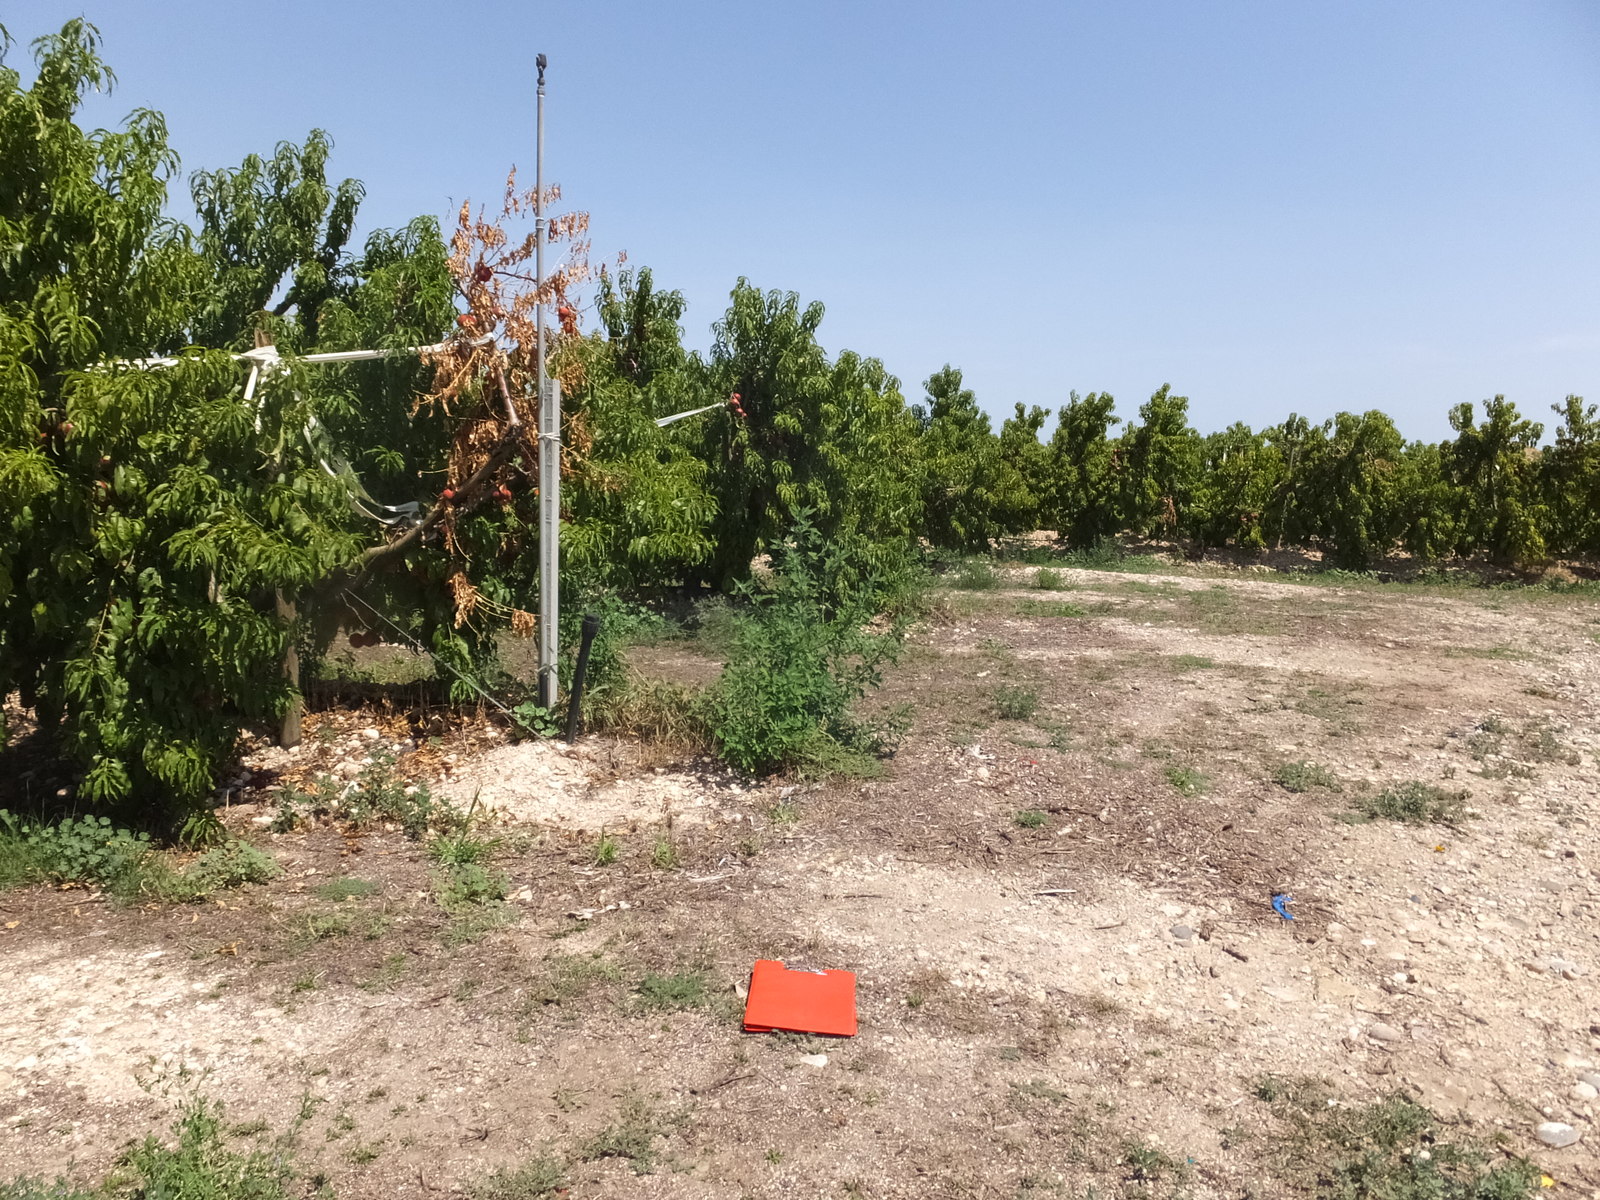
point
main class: Cropland
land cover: Other fruit trees and berries
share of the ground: > 75 %
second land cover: Spontaneously vegetated surfaces
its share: 10 - 25 %
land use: Agriculture (excluding fallow land and kitchen gardens)
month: August
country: ES
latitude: 41.6550
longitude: 0.2469
